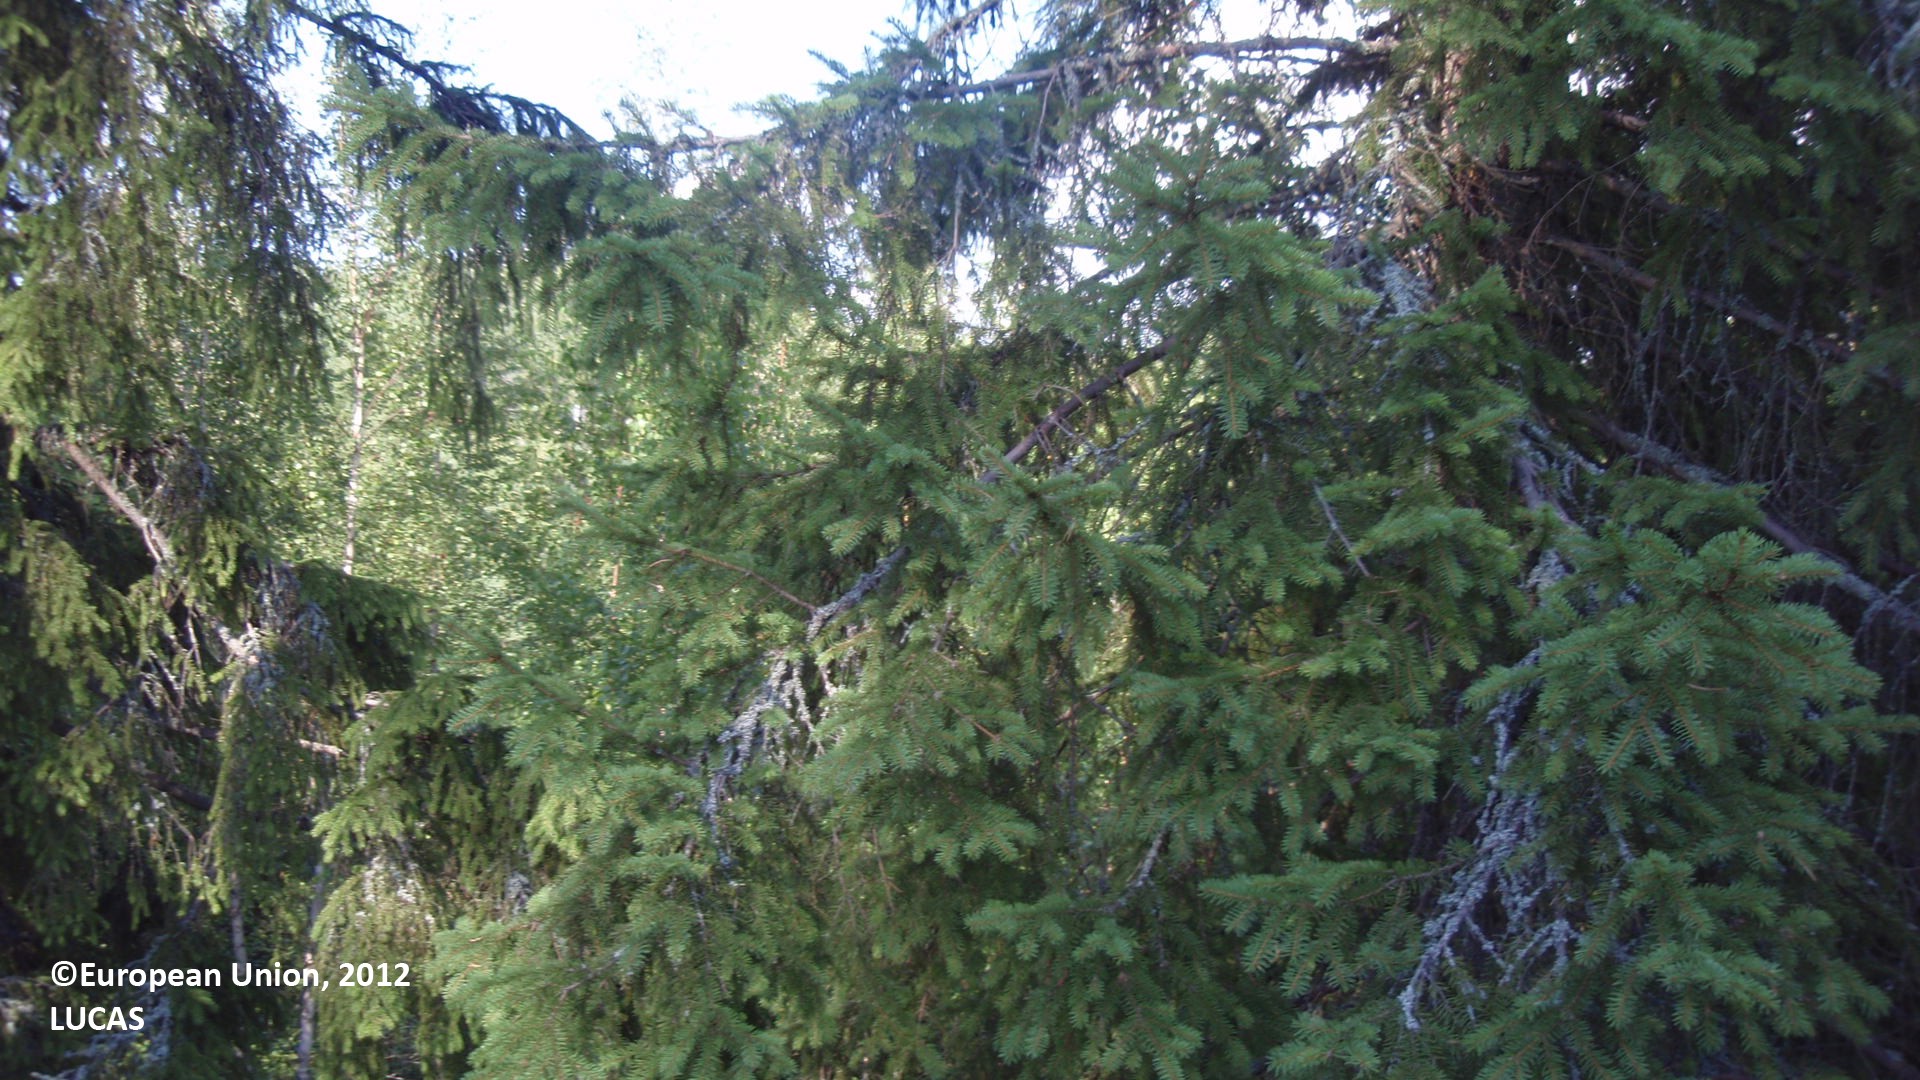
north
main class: Woodland
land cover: Pine dominated mixed woodland
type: boreal forest
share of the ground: 25 - 50 %
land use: Forestry
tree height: > 5 m
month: July
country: FI
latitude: 61.3796
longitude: 28.4582
